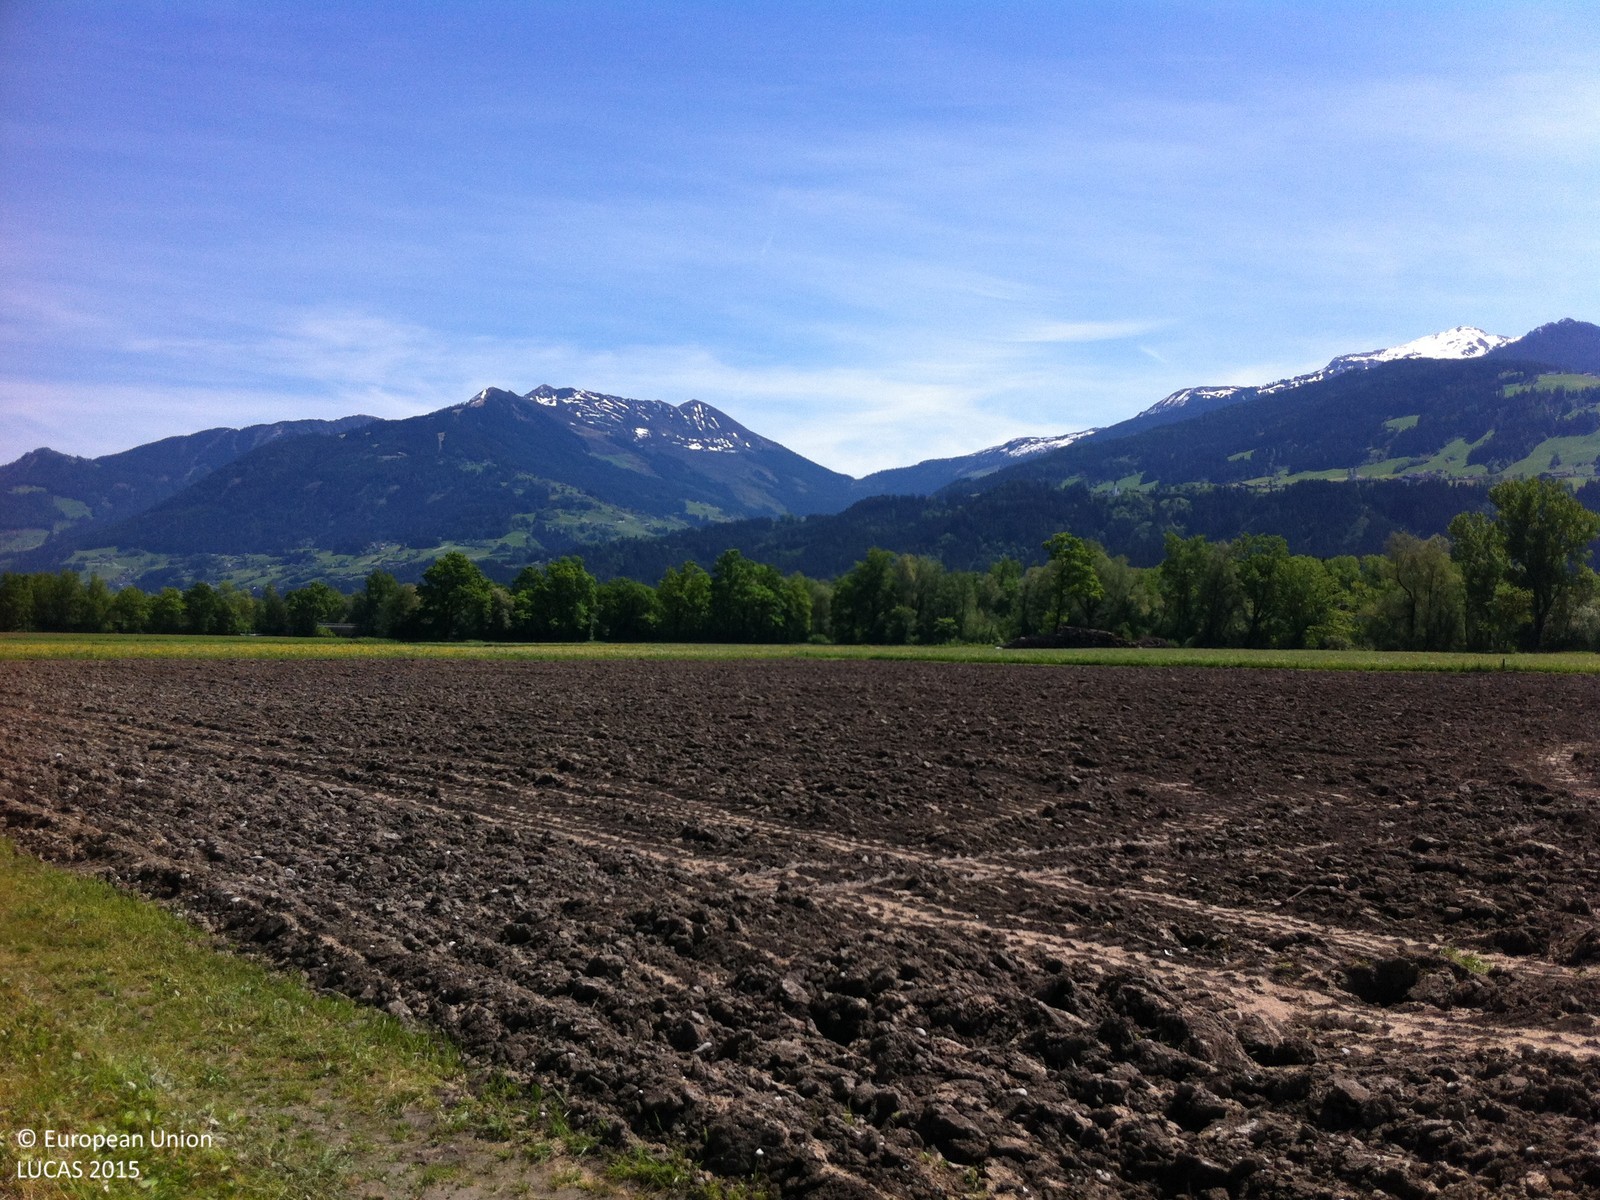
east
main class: Grassland
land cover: Spontaneously vegetated surfaces
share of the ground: > 75 %
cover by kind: herbaceous plants 90 %, shrubs 5 %, unconsolidated bare surface 5 %
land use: Abandoned areas
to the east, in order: Tracks; Other bare soil; Grassland without tree/shrub cover
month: May
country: AT
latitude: 47.3115
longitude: 11.6256
